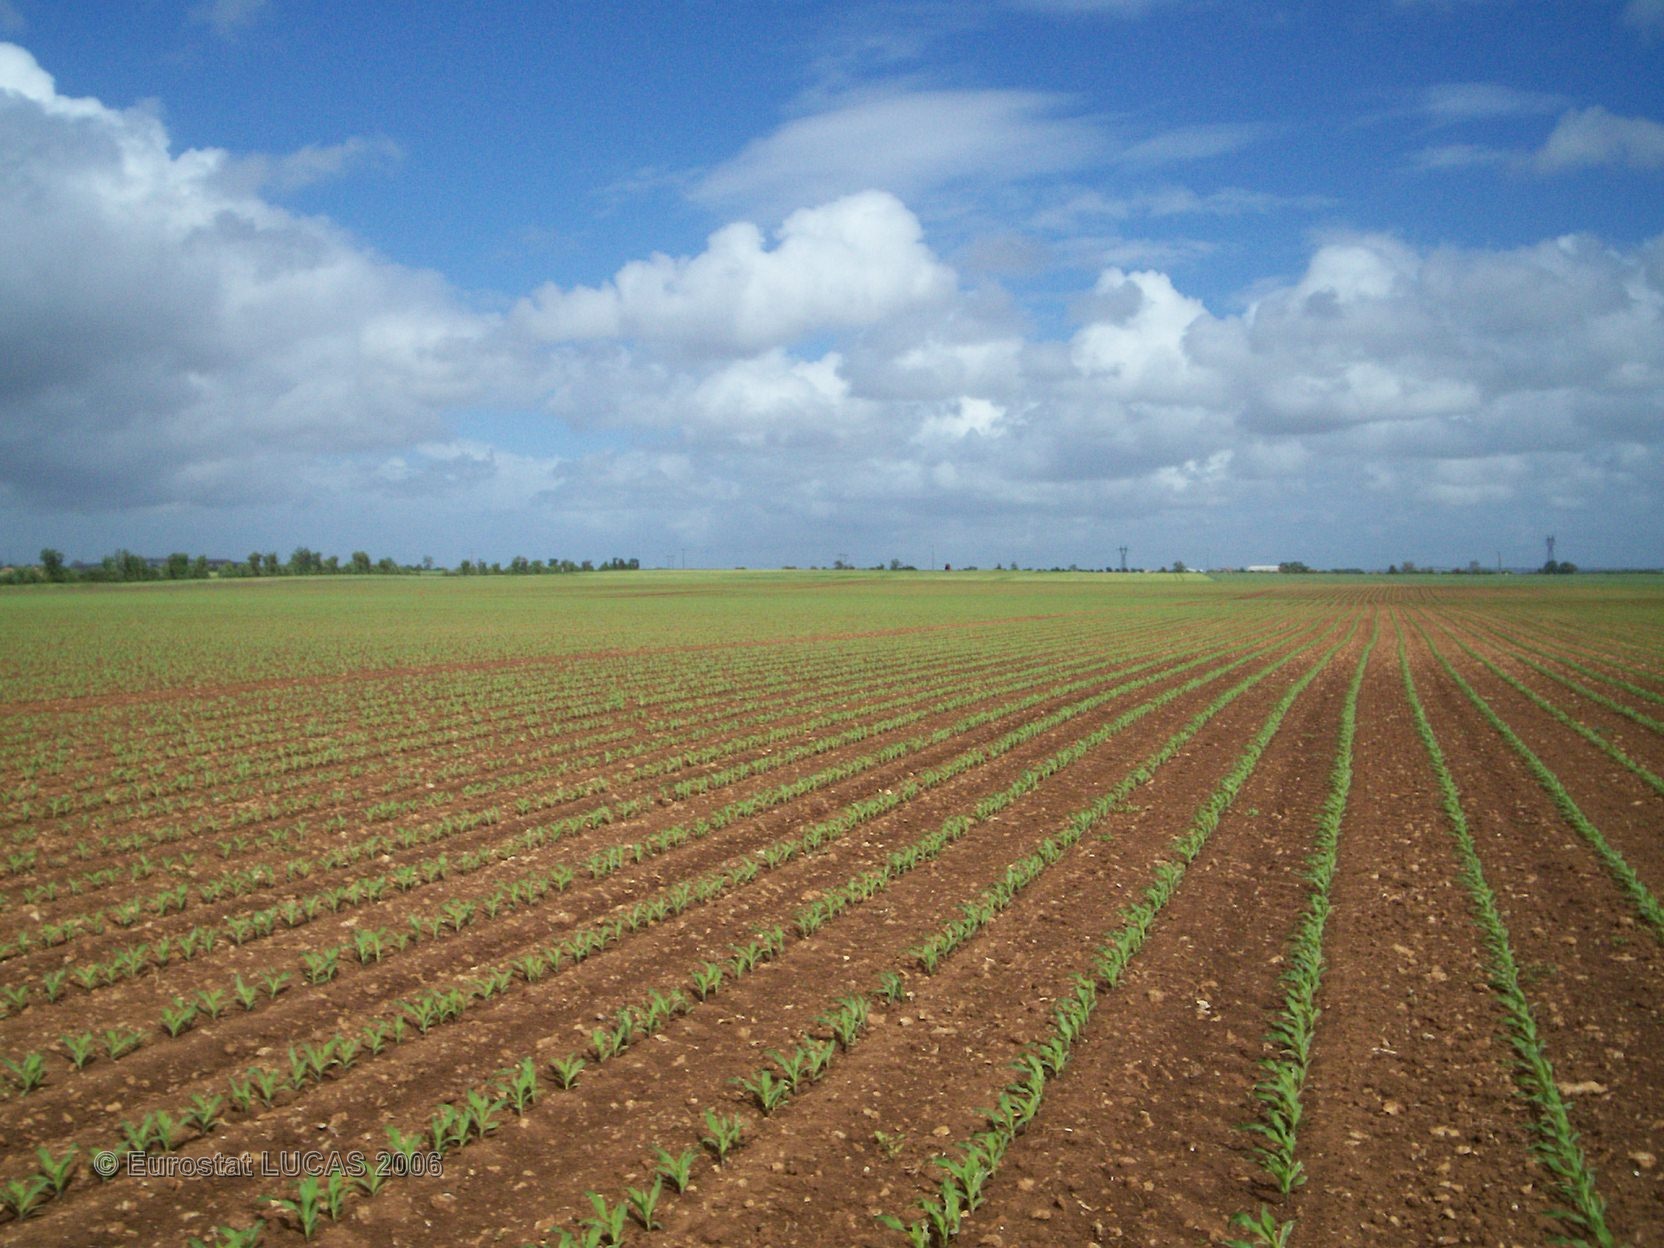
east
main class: Cropland
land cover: Maize
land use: Agriculture (excluding fallow land and kitchen gardens)
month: May
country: FR
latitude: 46.4239
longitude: -0.7639
